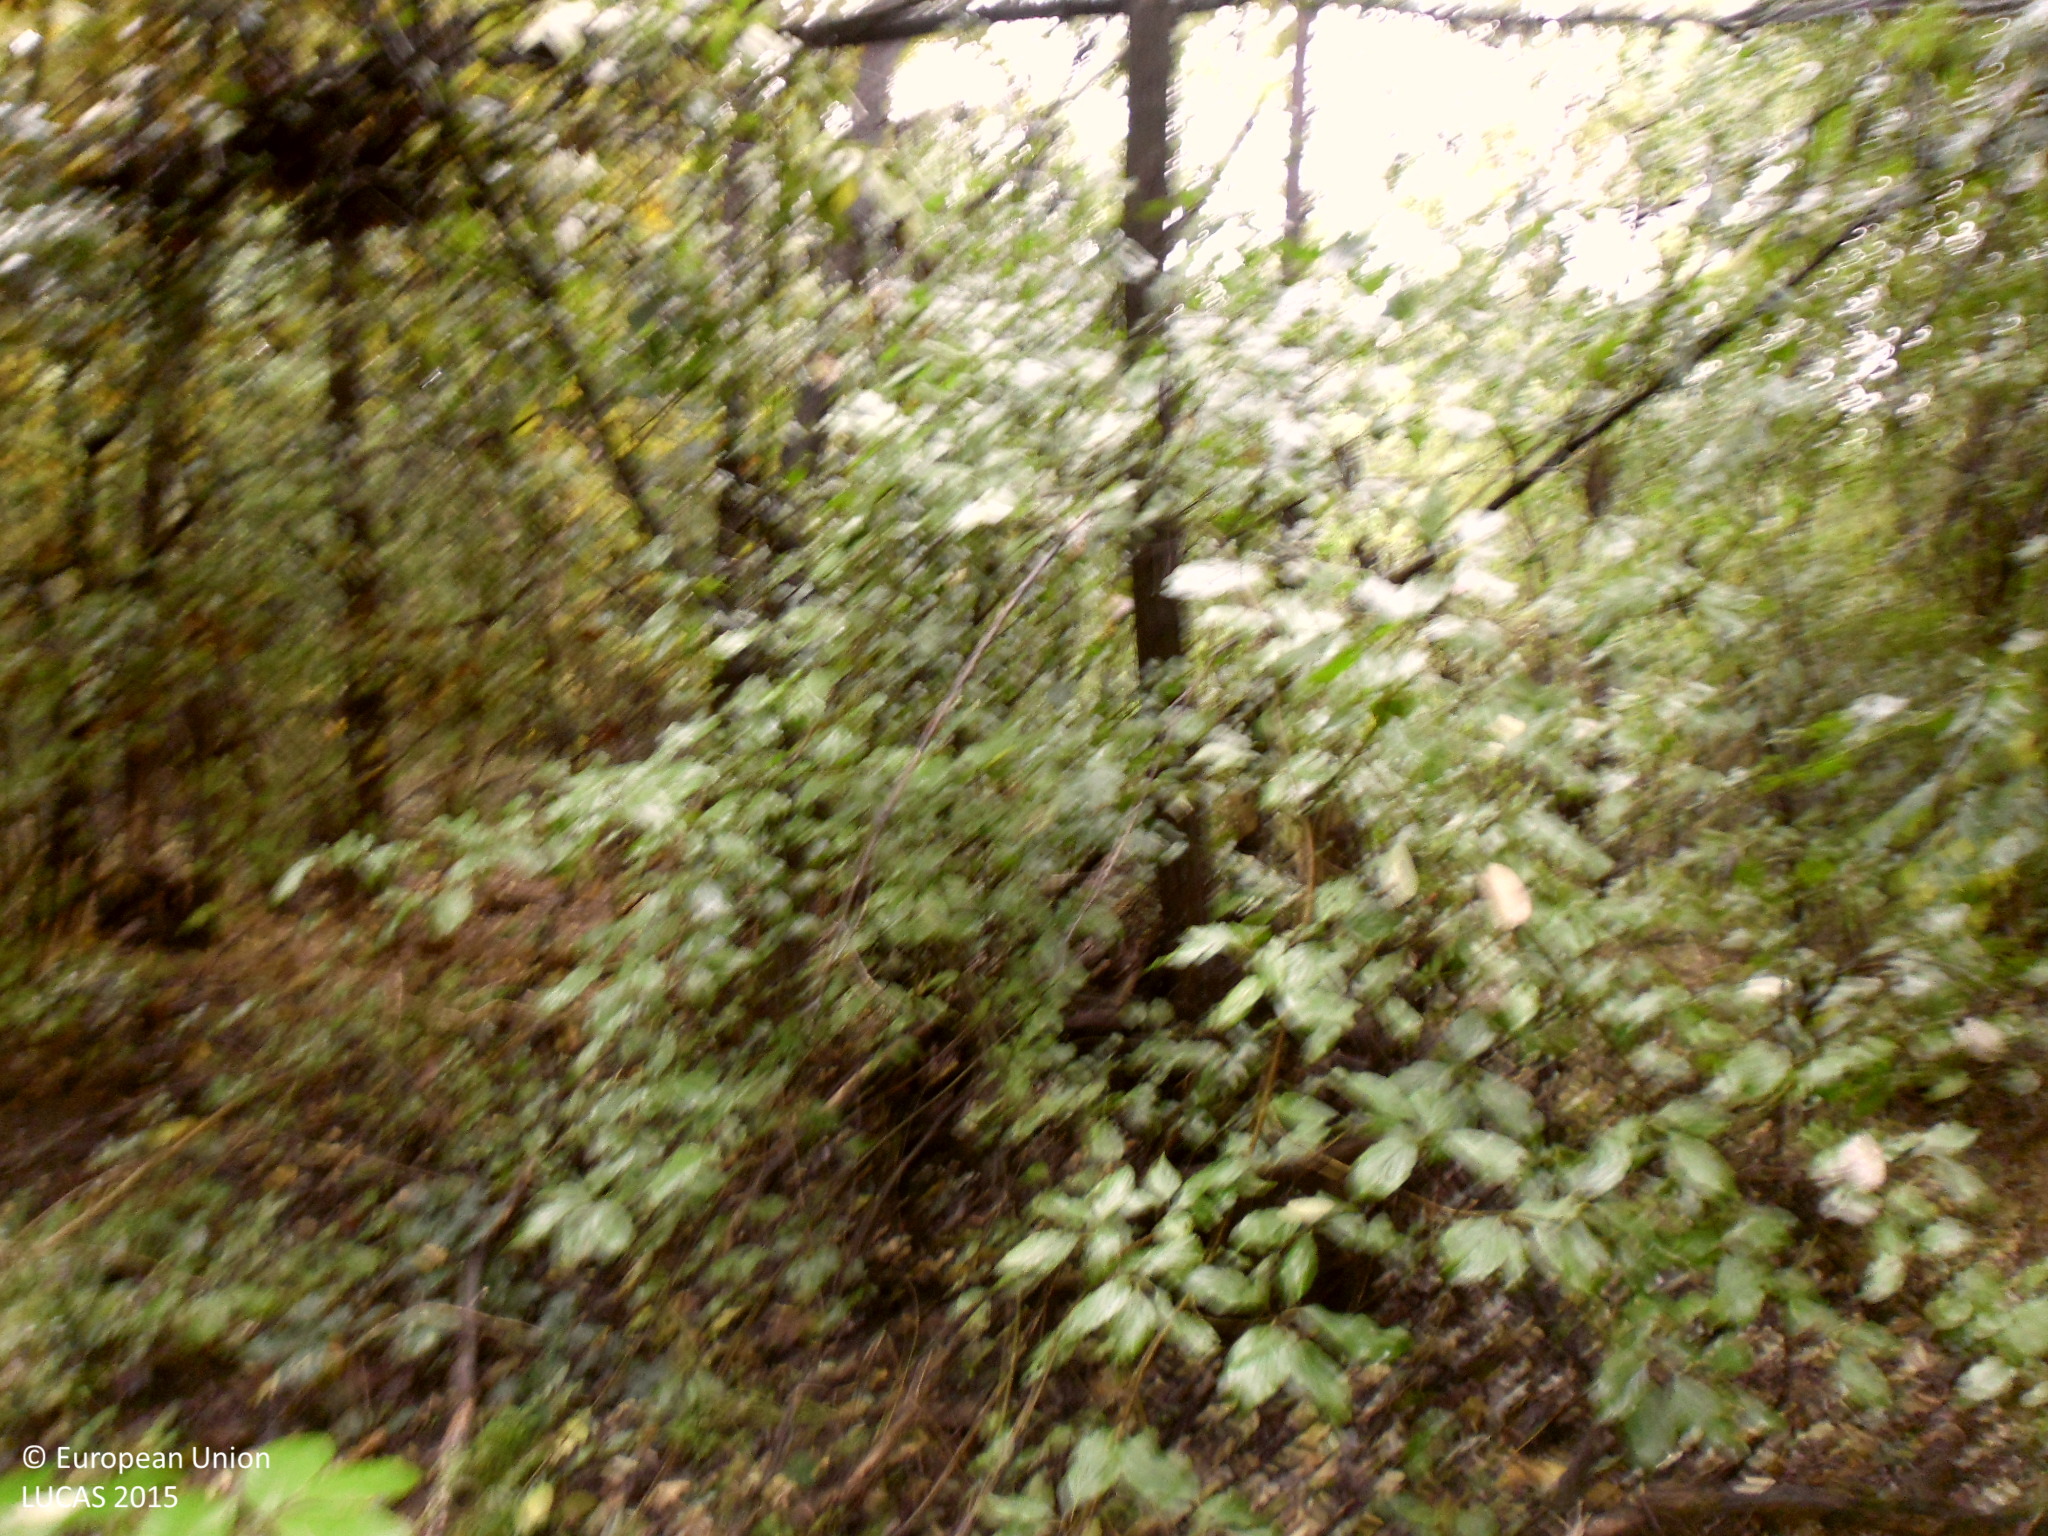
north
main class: Woodland
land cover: Broadleaved woodland
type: mesophytic deciduous forest
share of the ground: > 75 %
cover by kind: broadleaved forest trees 100 %
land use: Forestry
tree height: > 5 m
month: October
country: BG
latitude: 43.9166
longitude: 22.5249
